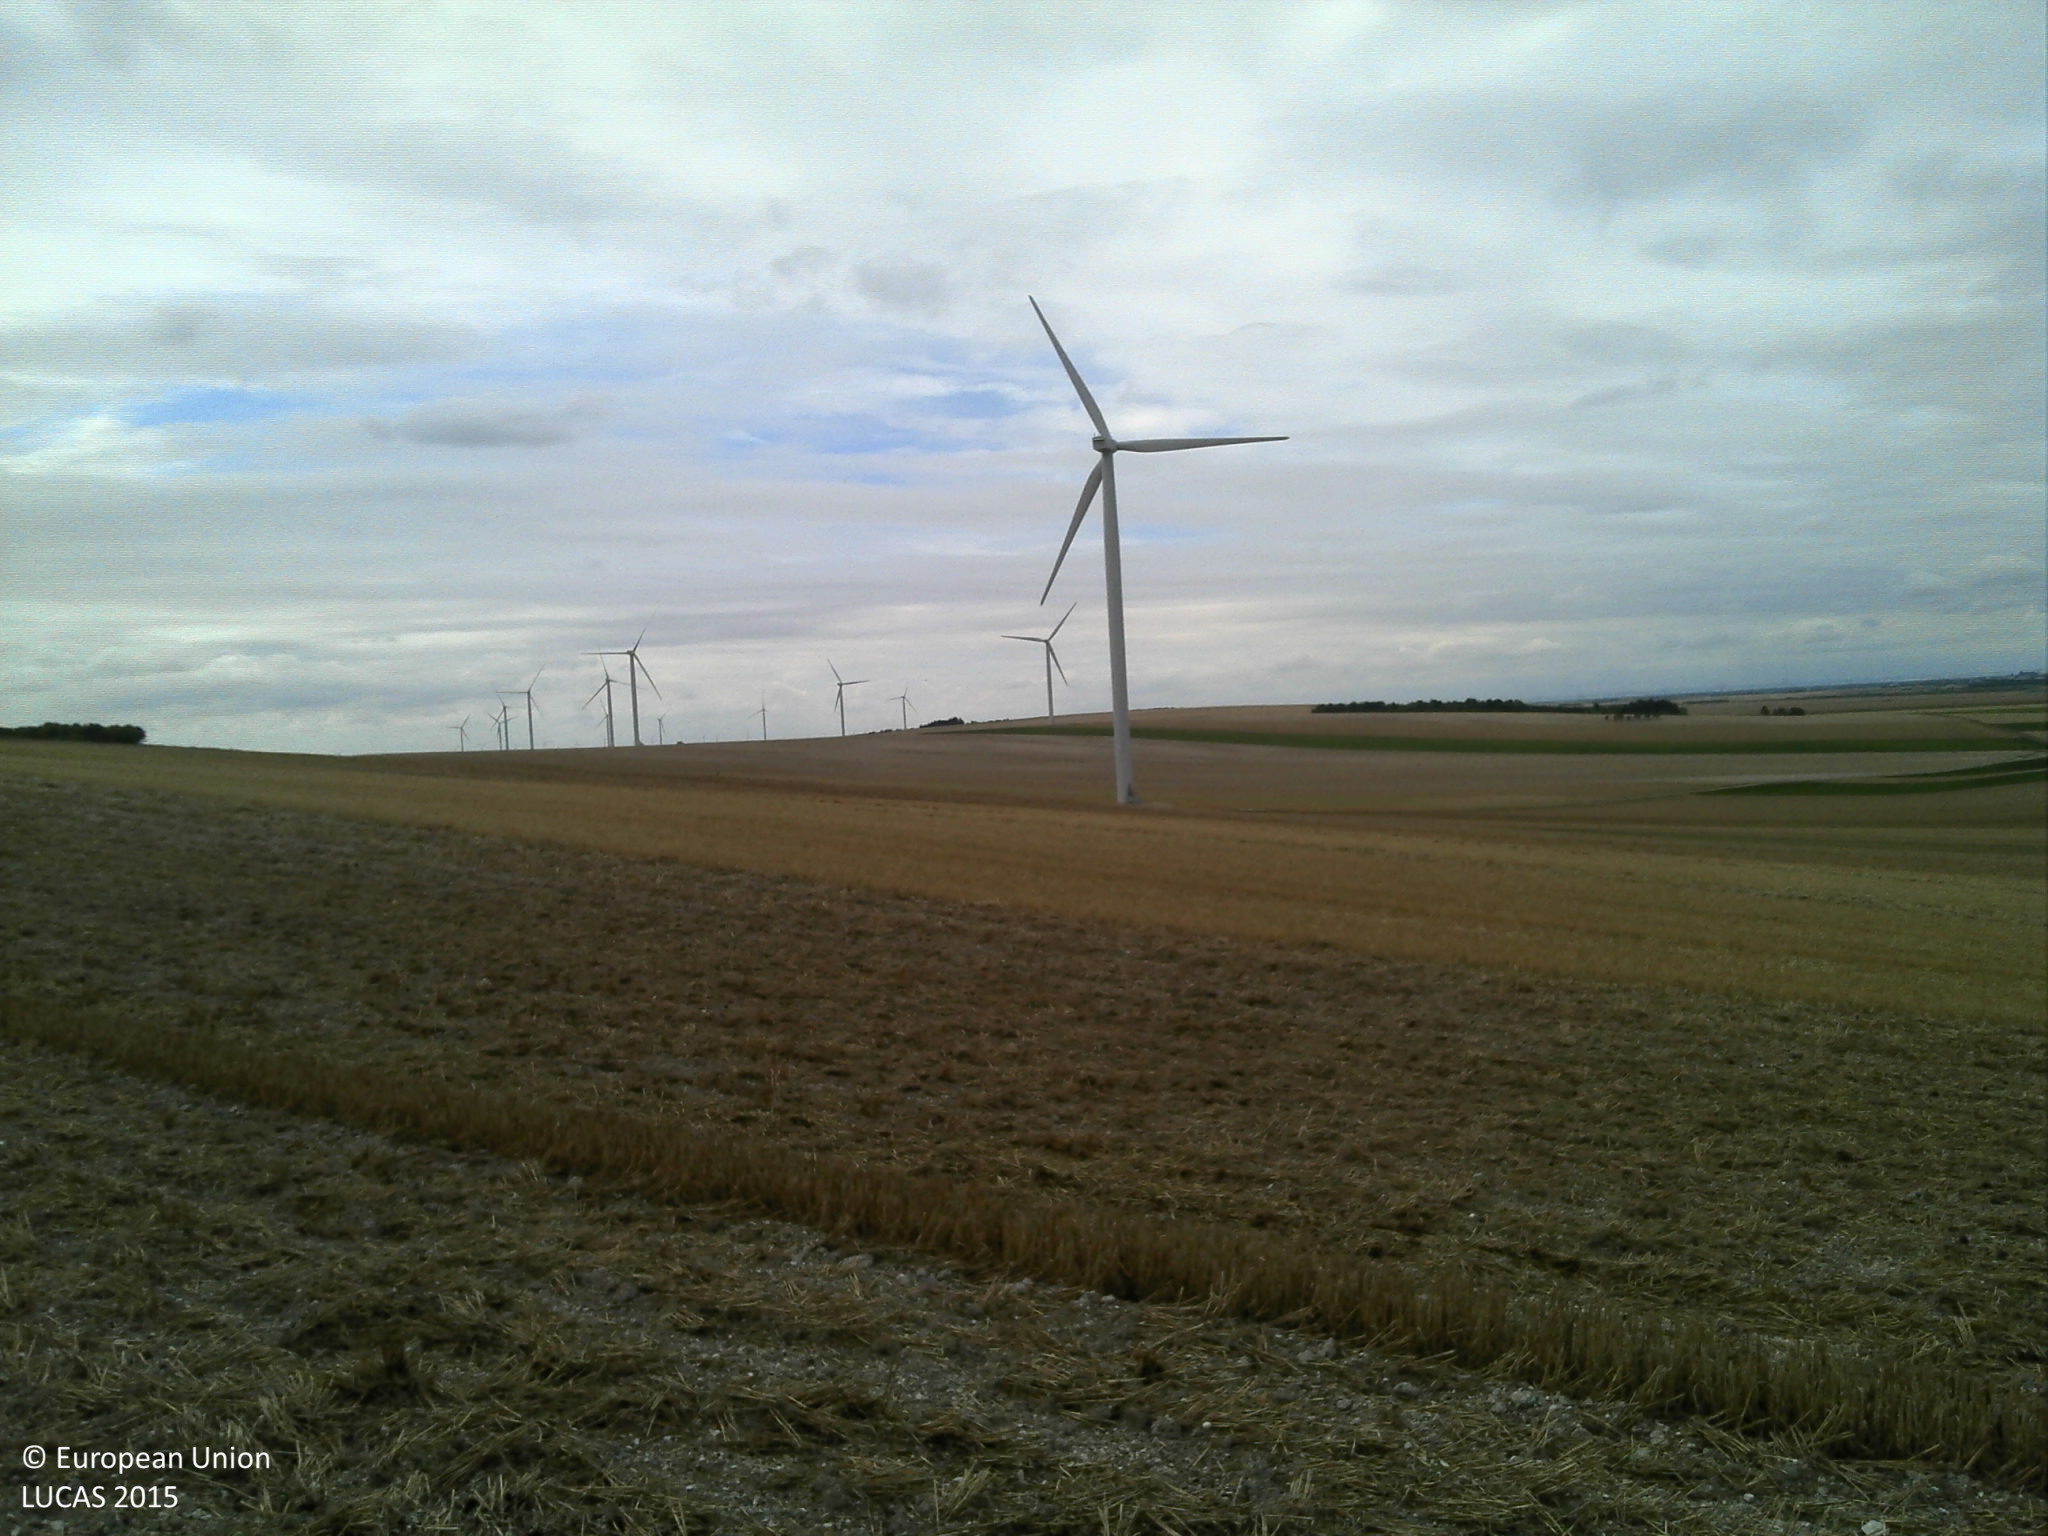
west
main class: Cropland
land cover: Common wheat
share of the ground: 25 - 50 %
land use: Agriculture (excluding fallow land and kitchen gardens)
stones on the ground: 10 - 25 %
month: August
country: FR
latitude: 48.4882
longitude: 4.2461
